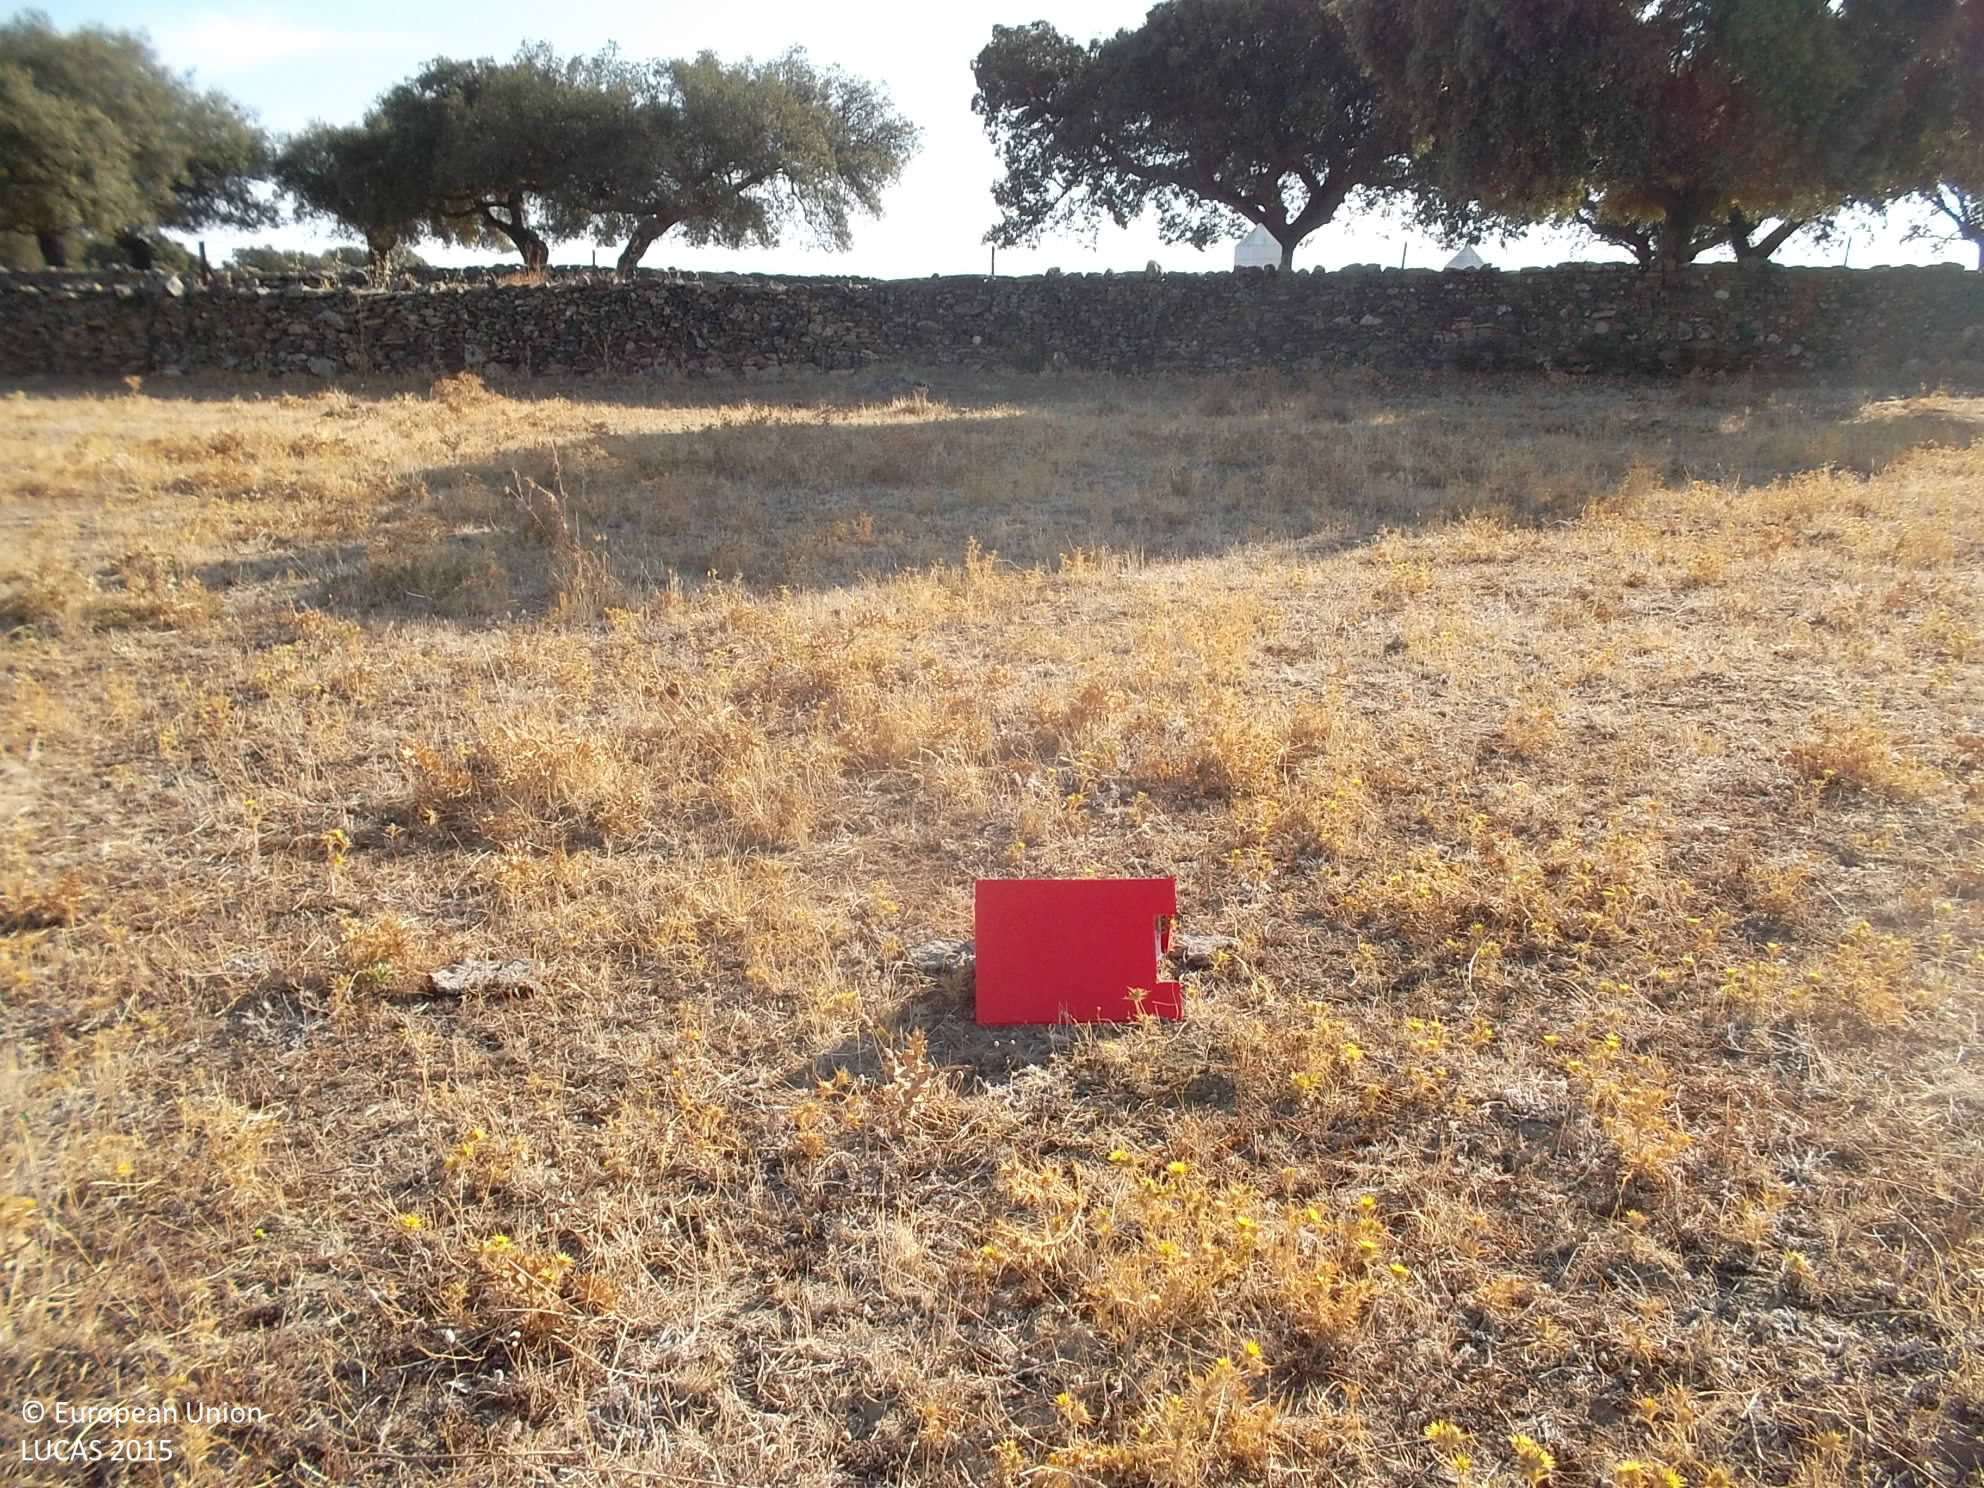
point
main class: Grassland
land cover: Grassland without tree/shrub cover
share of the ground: > 75 %
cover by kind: herbaceous plants 100 %
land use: Agriculture (excluding fallow land and kitchen gardens)
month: September
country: ES
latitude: 38.1740
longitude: -6.5197
